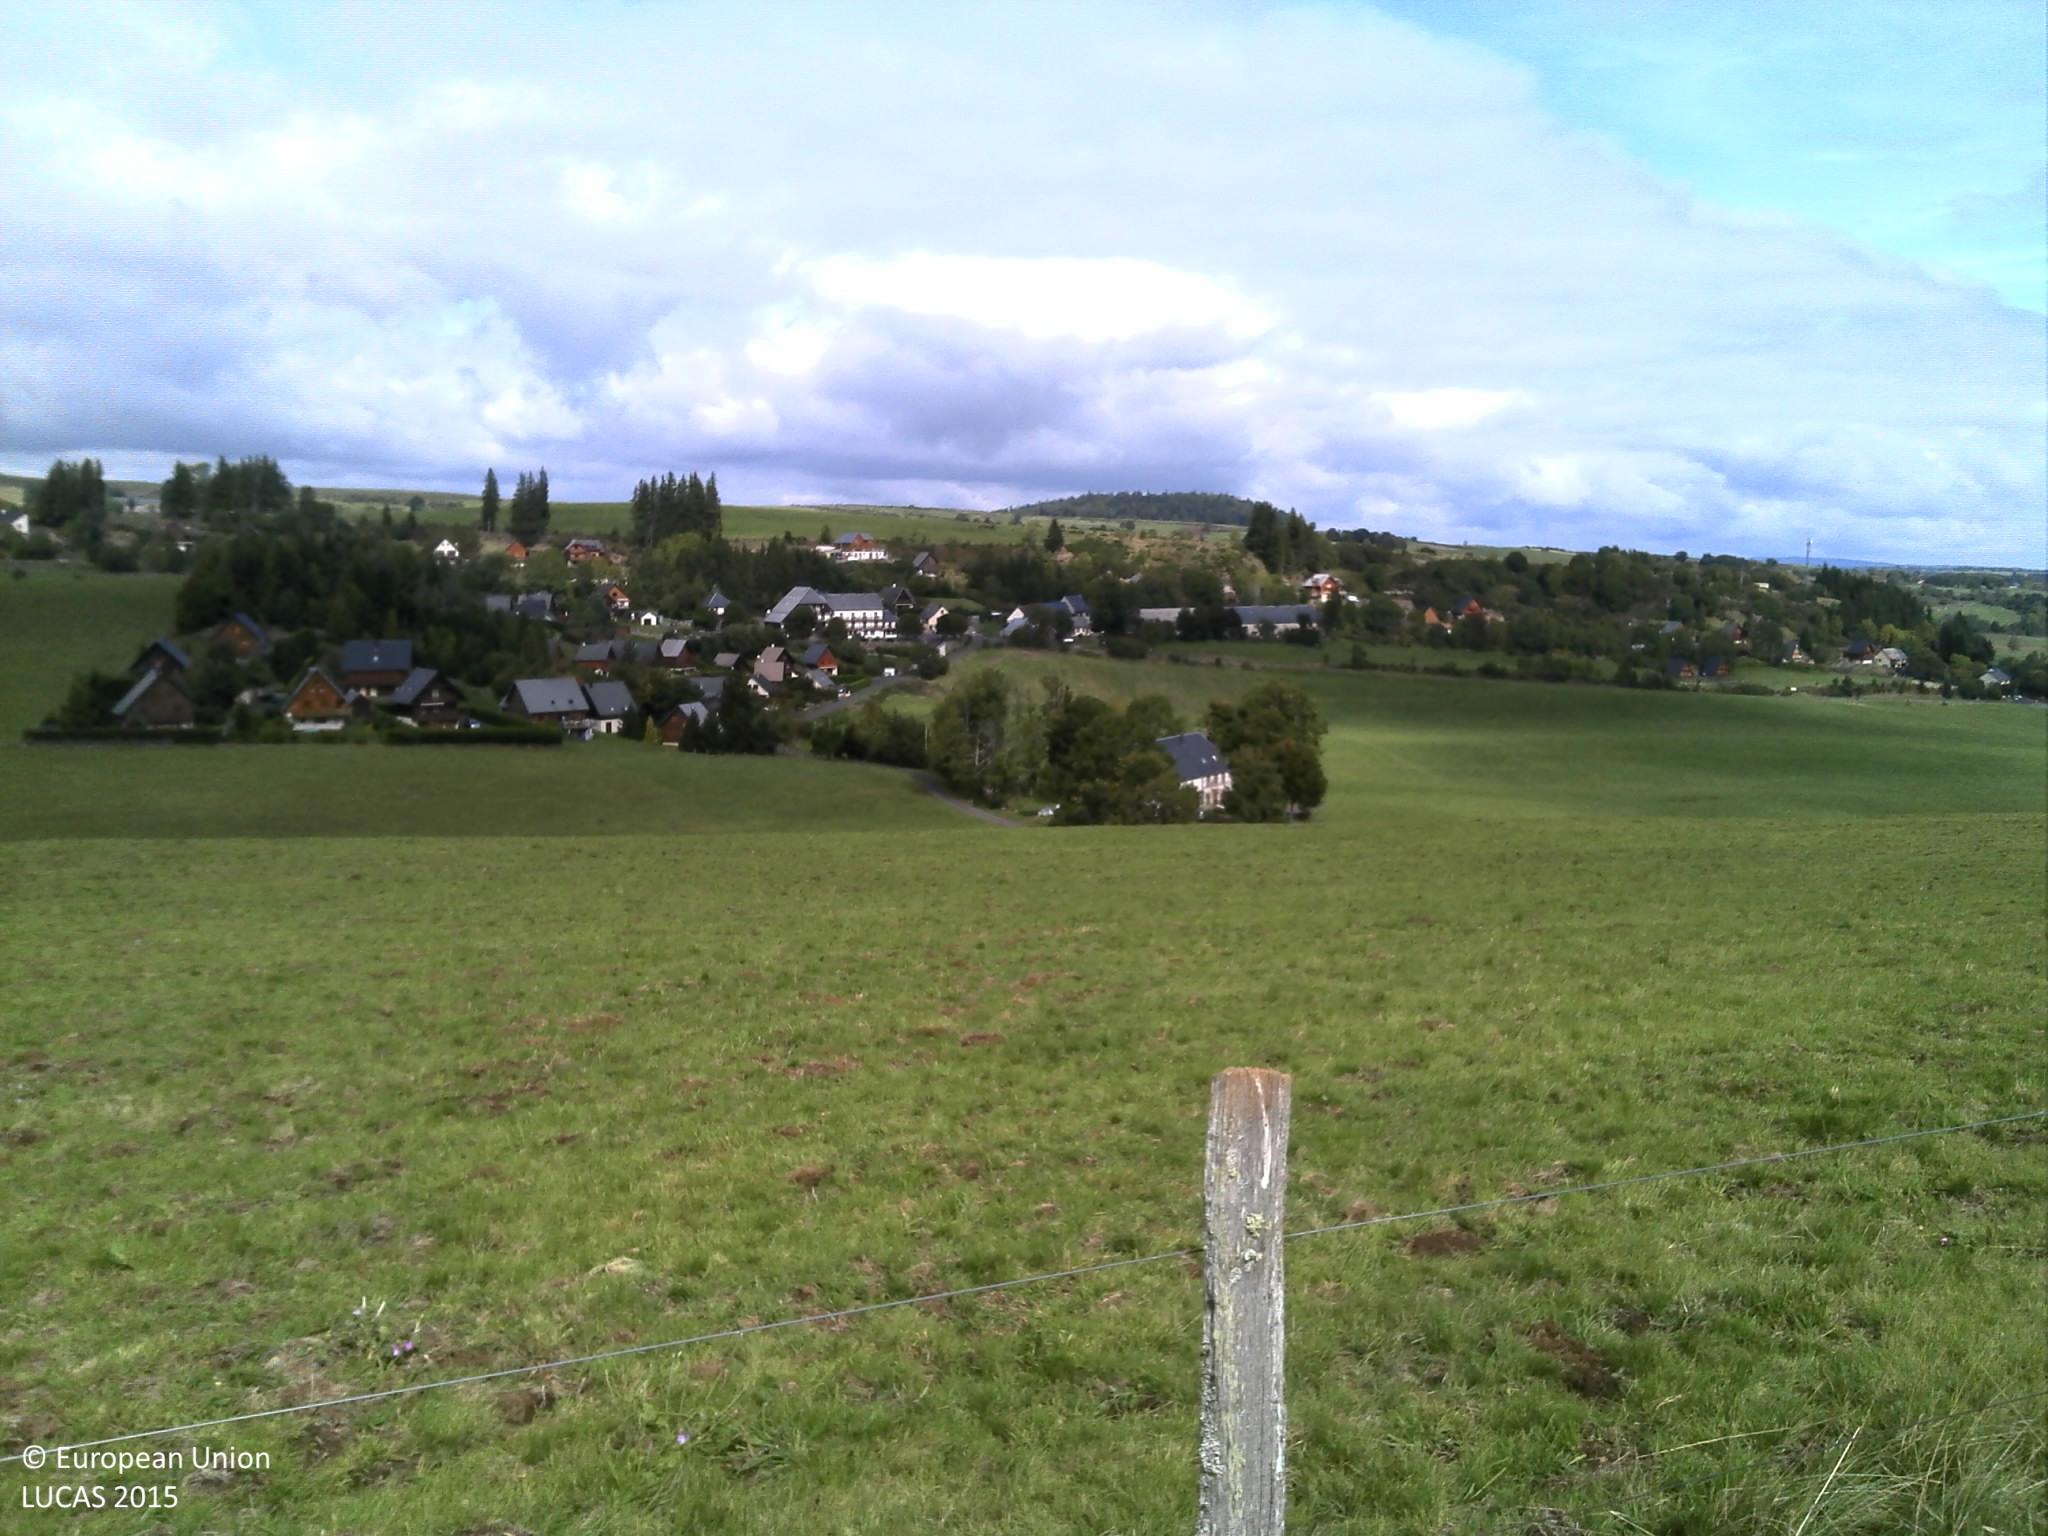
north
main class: Grassland
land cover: Grassland without tree/shrub cover
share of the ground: > 75 %
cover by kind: herbaceous plants 100 %
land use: Agriculture (excluding fallow land and kitchen gardens)
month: September
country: FR
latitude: 45.5019
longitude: 2.9227
